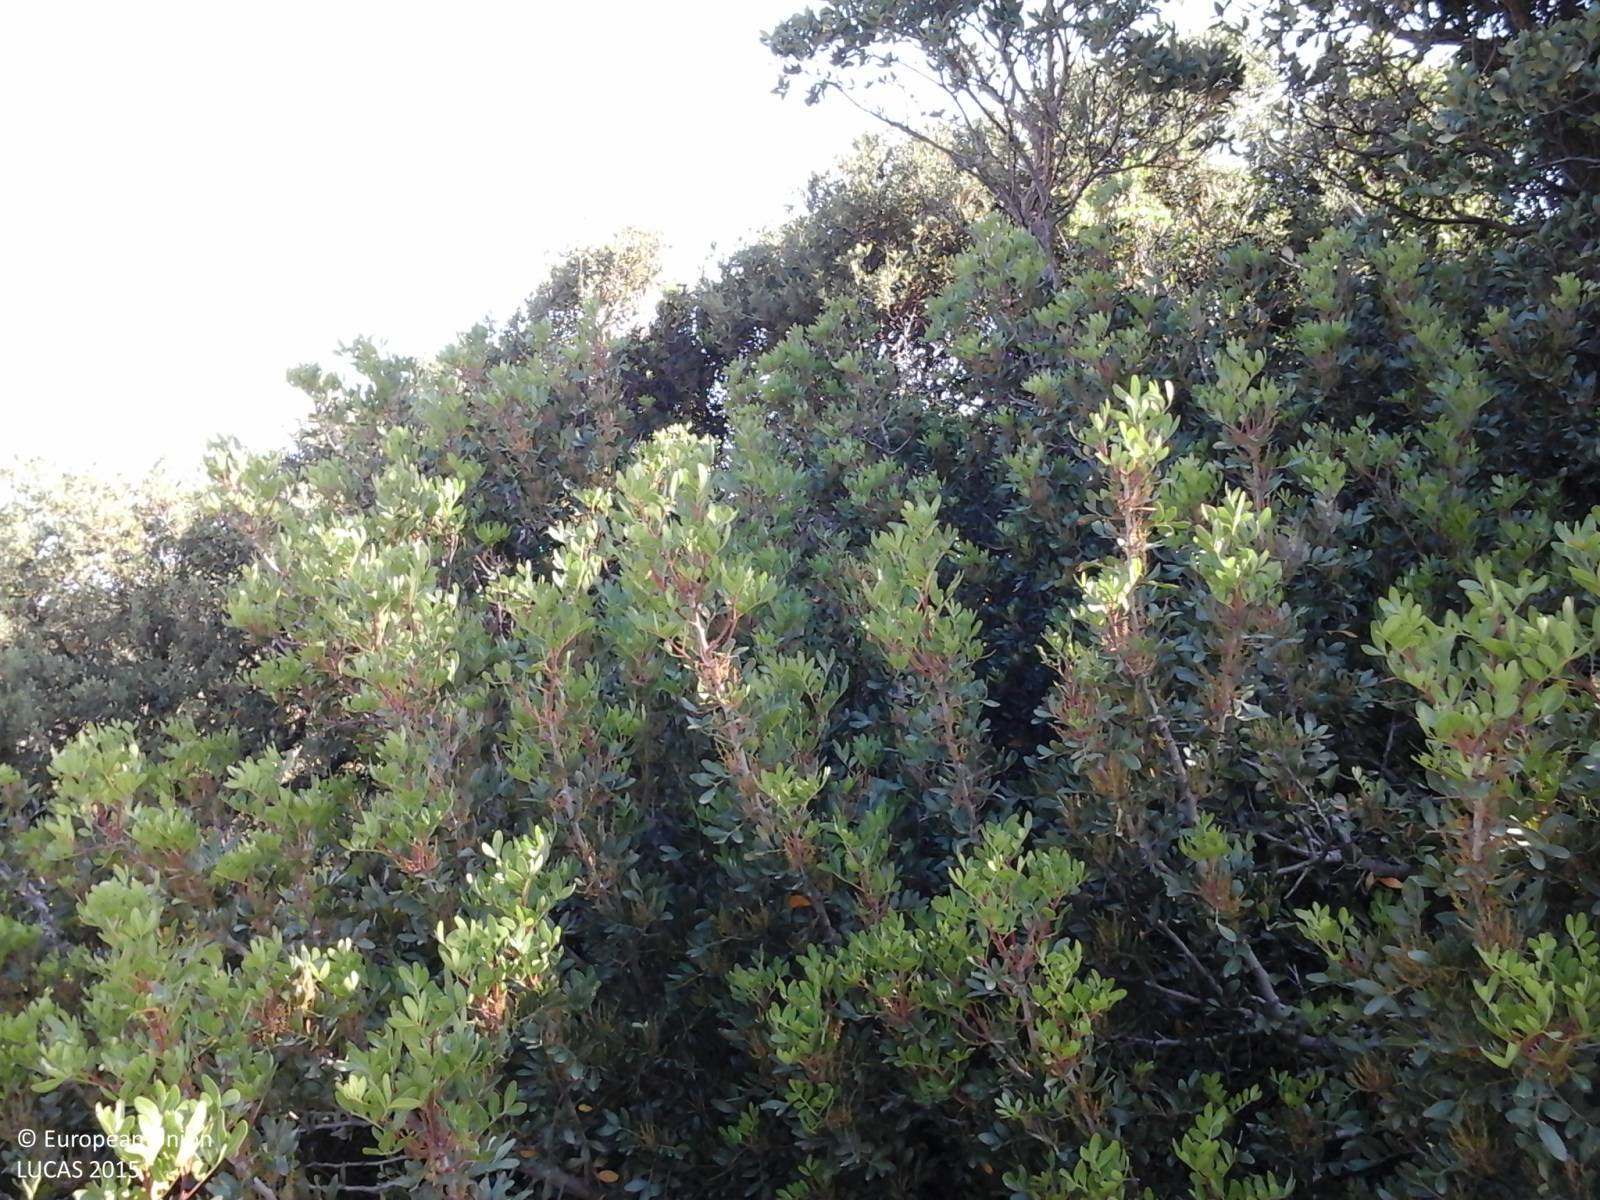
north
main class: Shrubland
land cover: Shrubland without tree cover
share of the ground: 50 - 75 %
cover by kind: herbaceous plants 60 %, shrubs 40 %
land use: Agriculture (excluding fallow land and kitchen gardens)
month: June
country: IT
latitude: 40.8558
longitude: 8.6894
